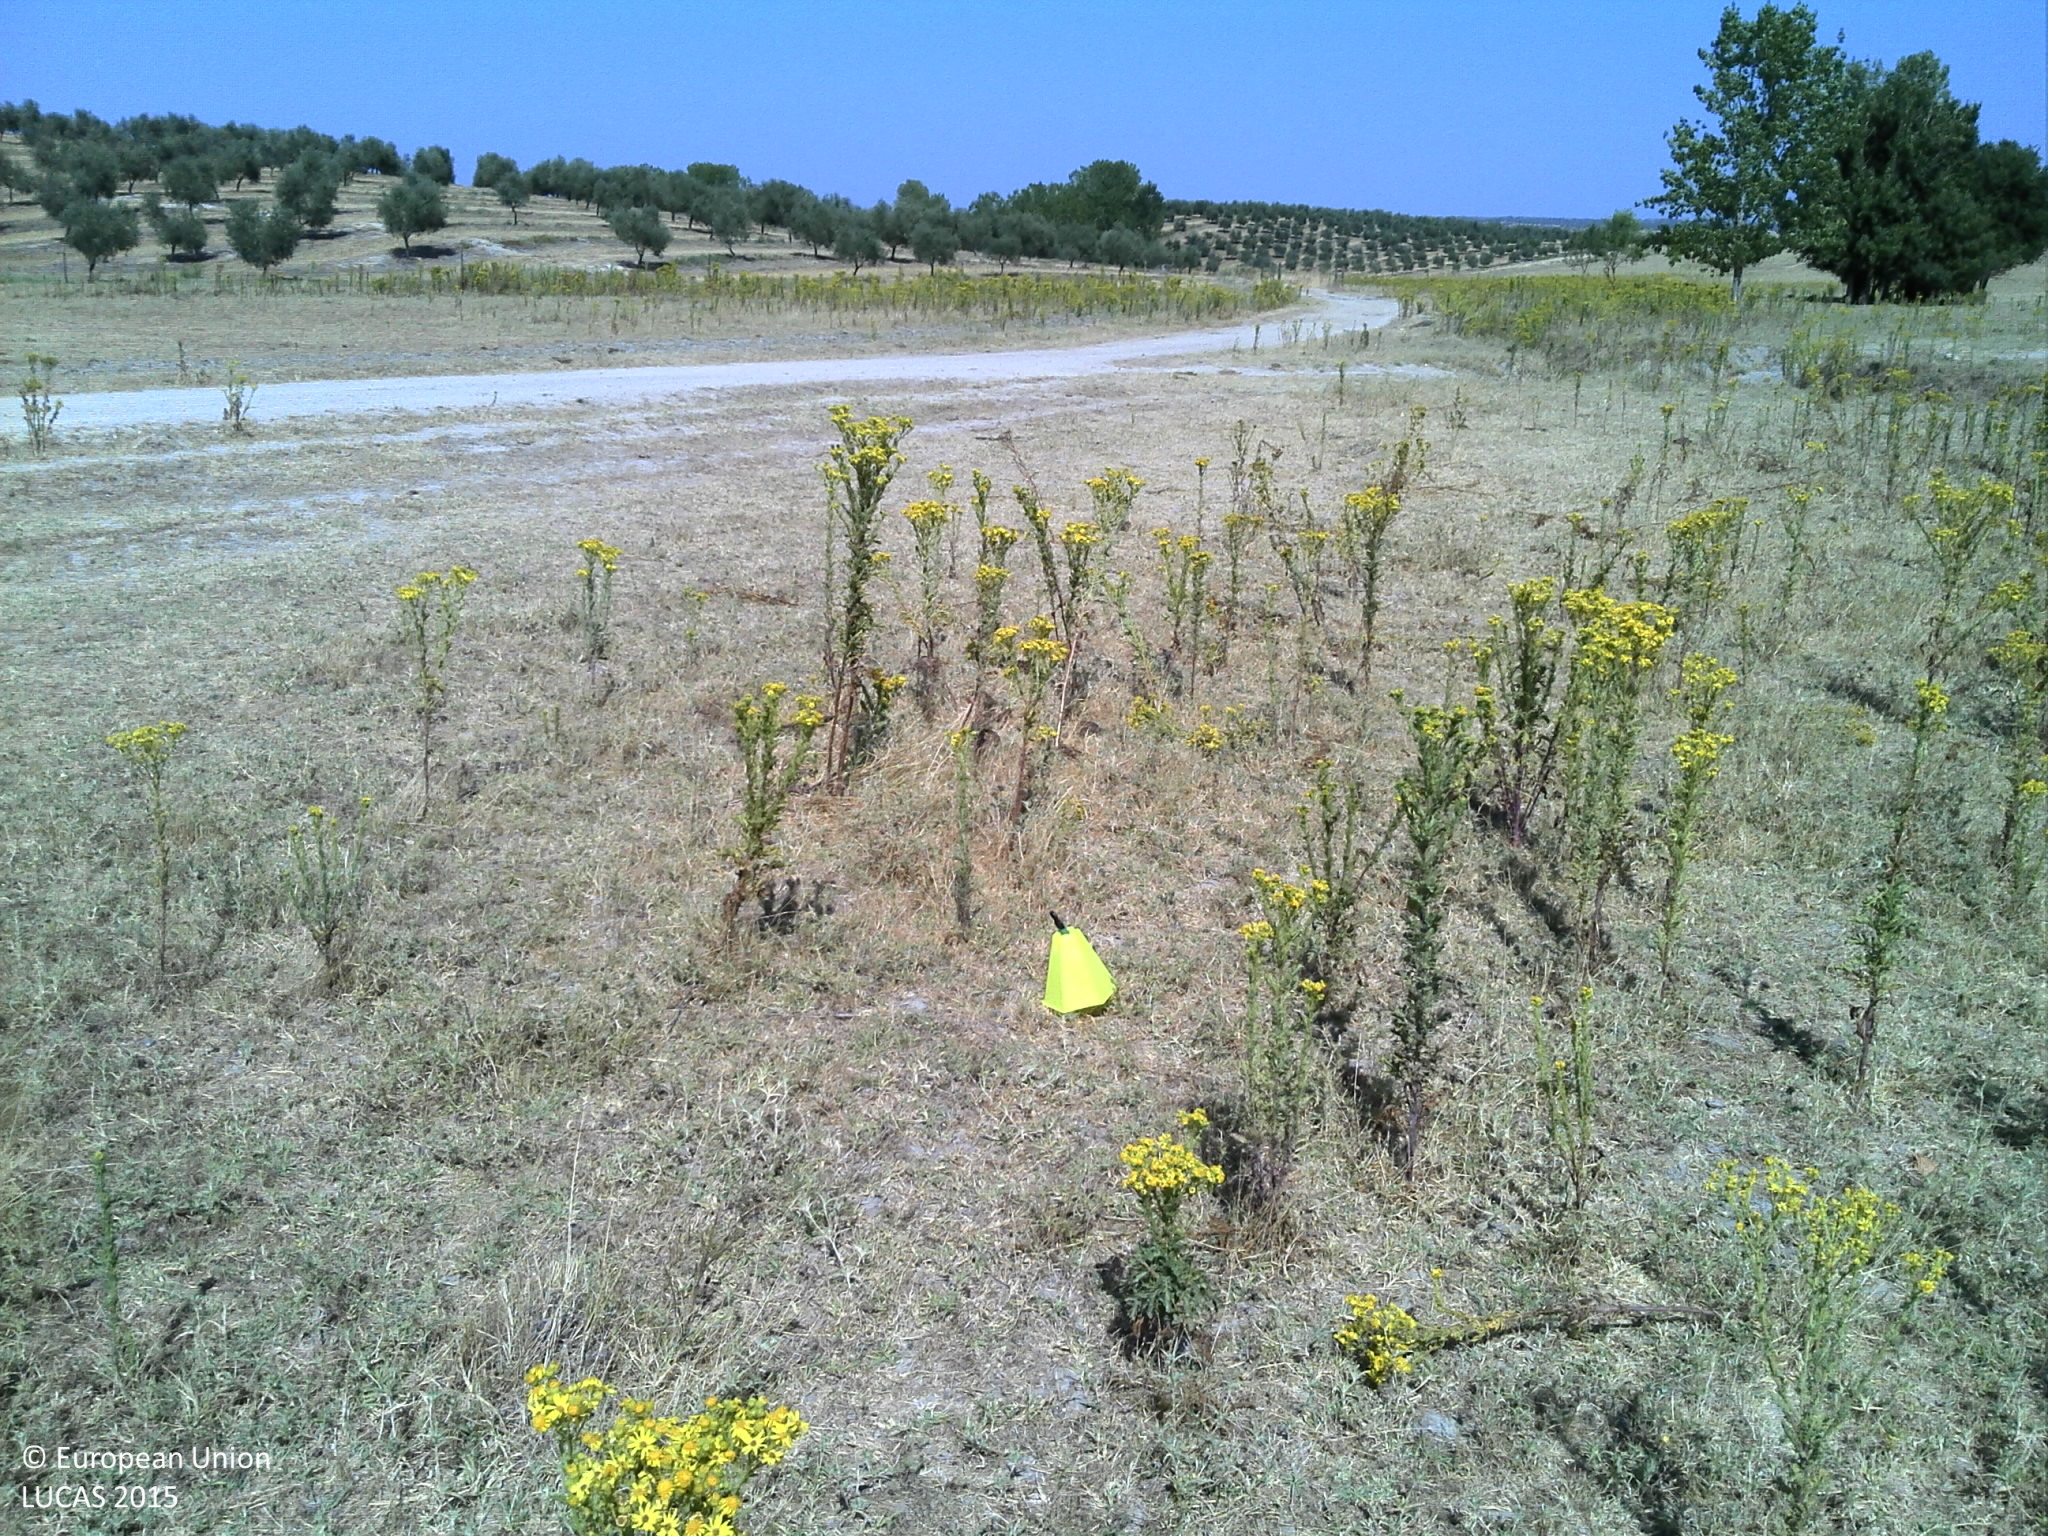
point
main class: Grassland
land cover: Grassland without tree/shrub cover
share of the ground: 25 - 50 %
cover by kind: unconsolidated bare surface 75 %, herbaceous plants 25 %
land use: Agriculture (excluding fallow land and kitchen gardens)
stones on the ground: < 10 %
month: July
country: PT
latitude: 38.5699
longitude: -7.6983
